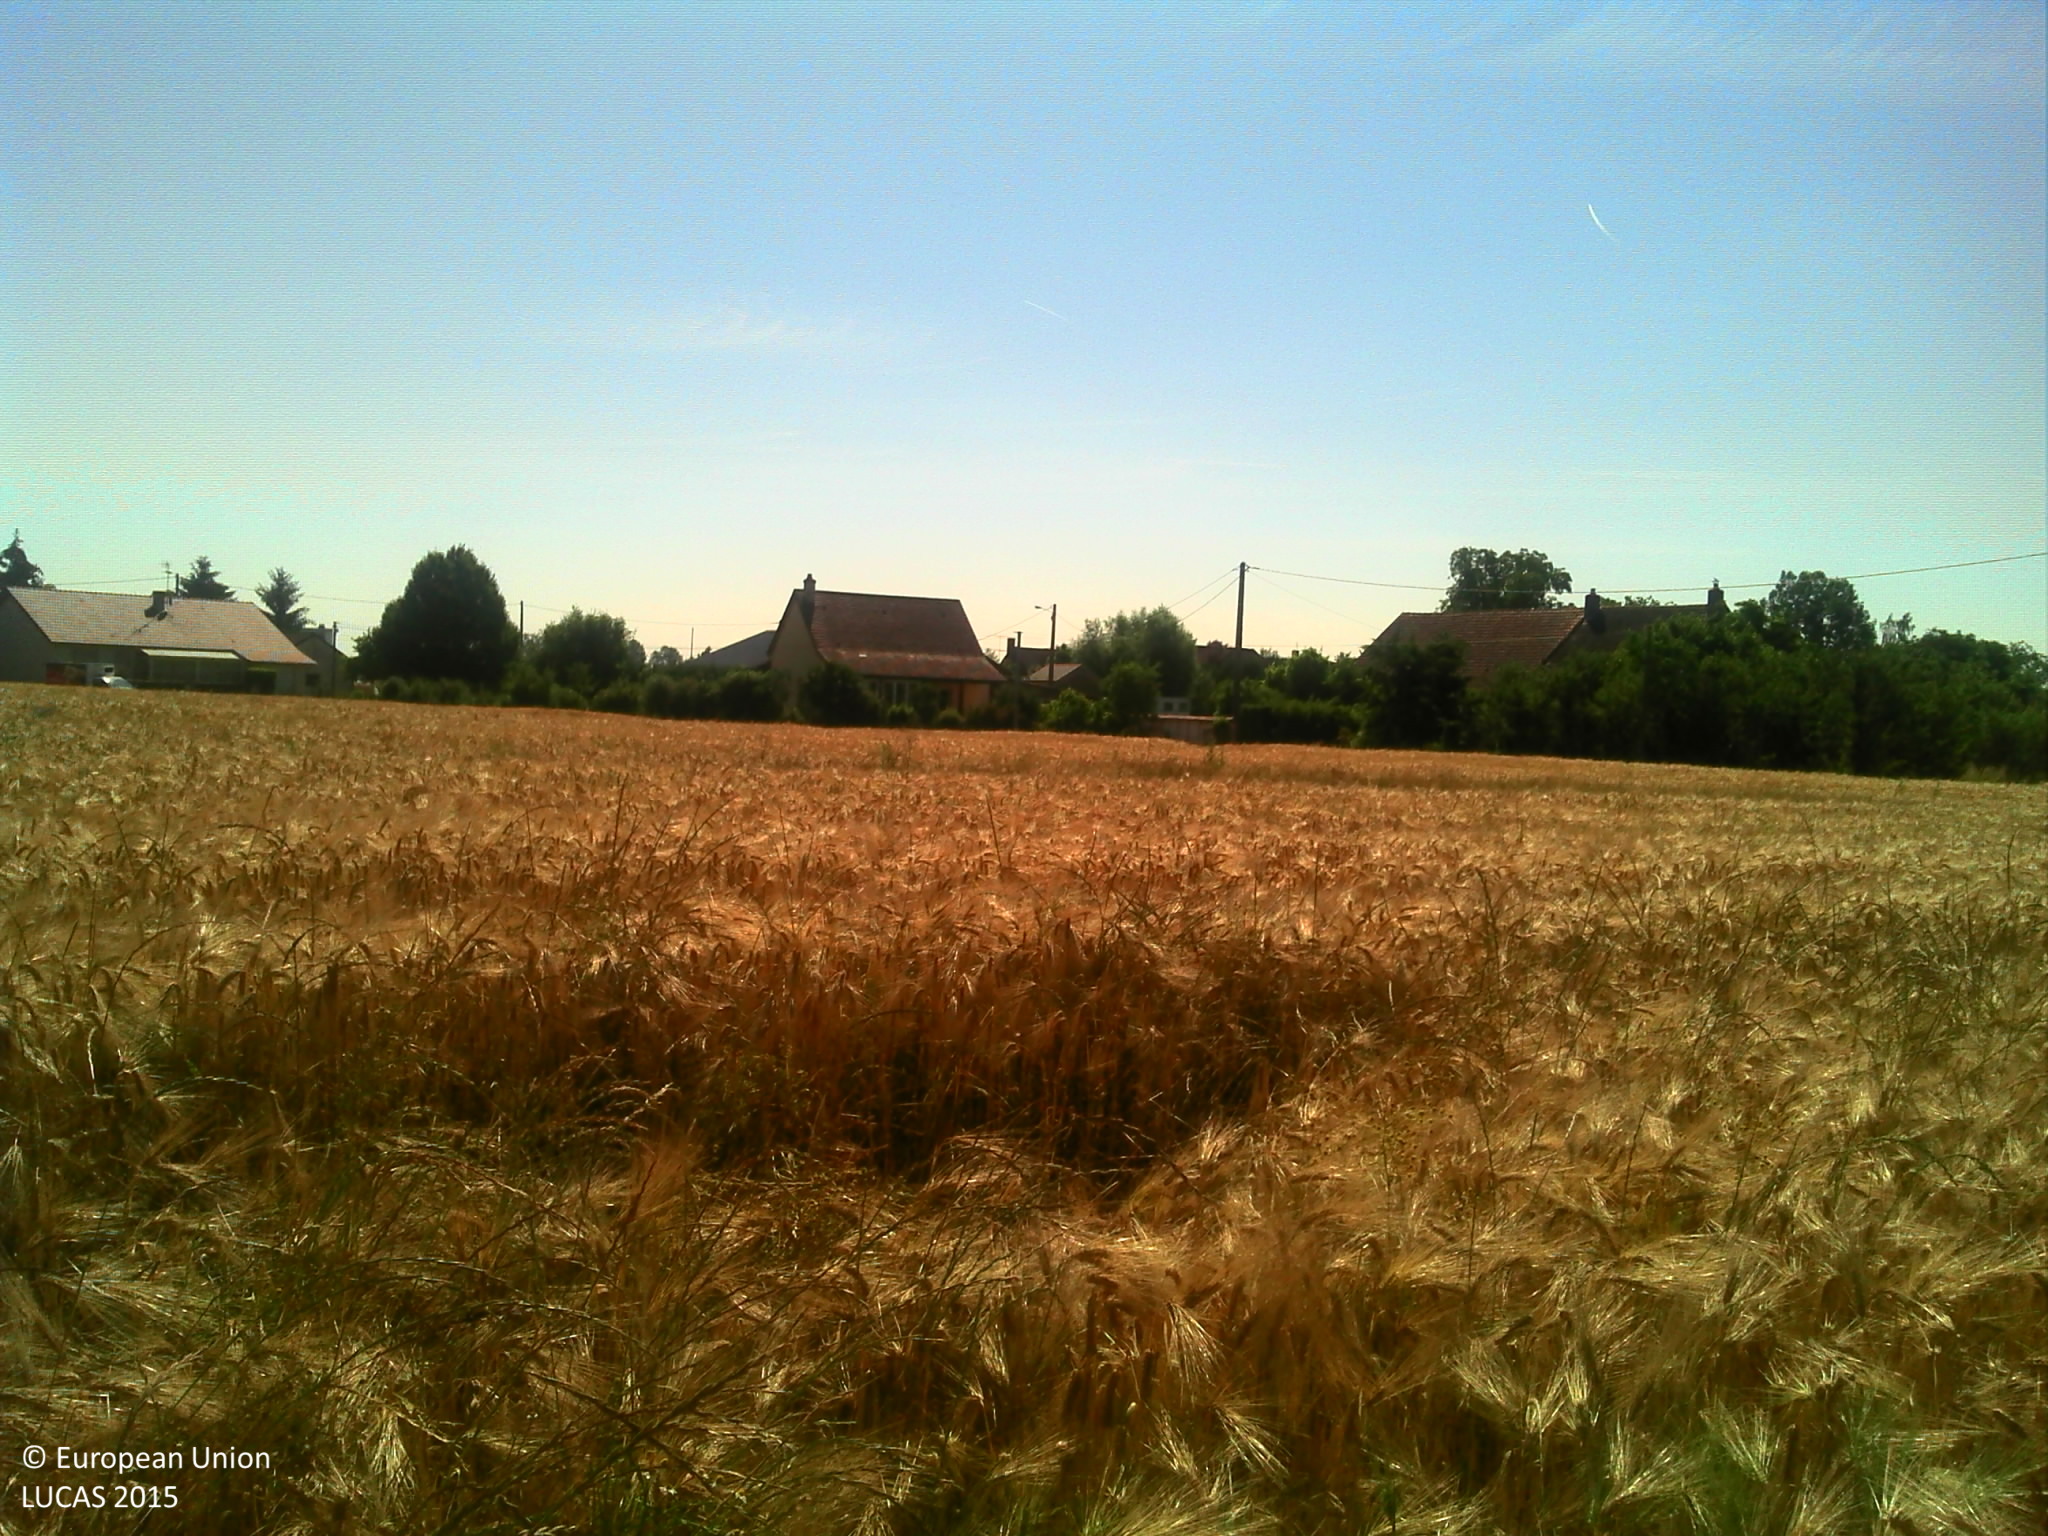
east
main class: Cropland
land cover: Barley
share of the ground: > 75 %
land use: Agriculture (excluding fallow land and kitchen gardens)
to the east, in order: Barley; Artificial constructions in urban areas; Grassland with sparse tree/shrub cover; Rivers and streams; Common wheat
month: June
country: FR
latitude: 47.0921
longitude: 5.2191
